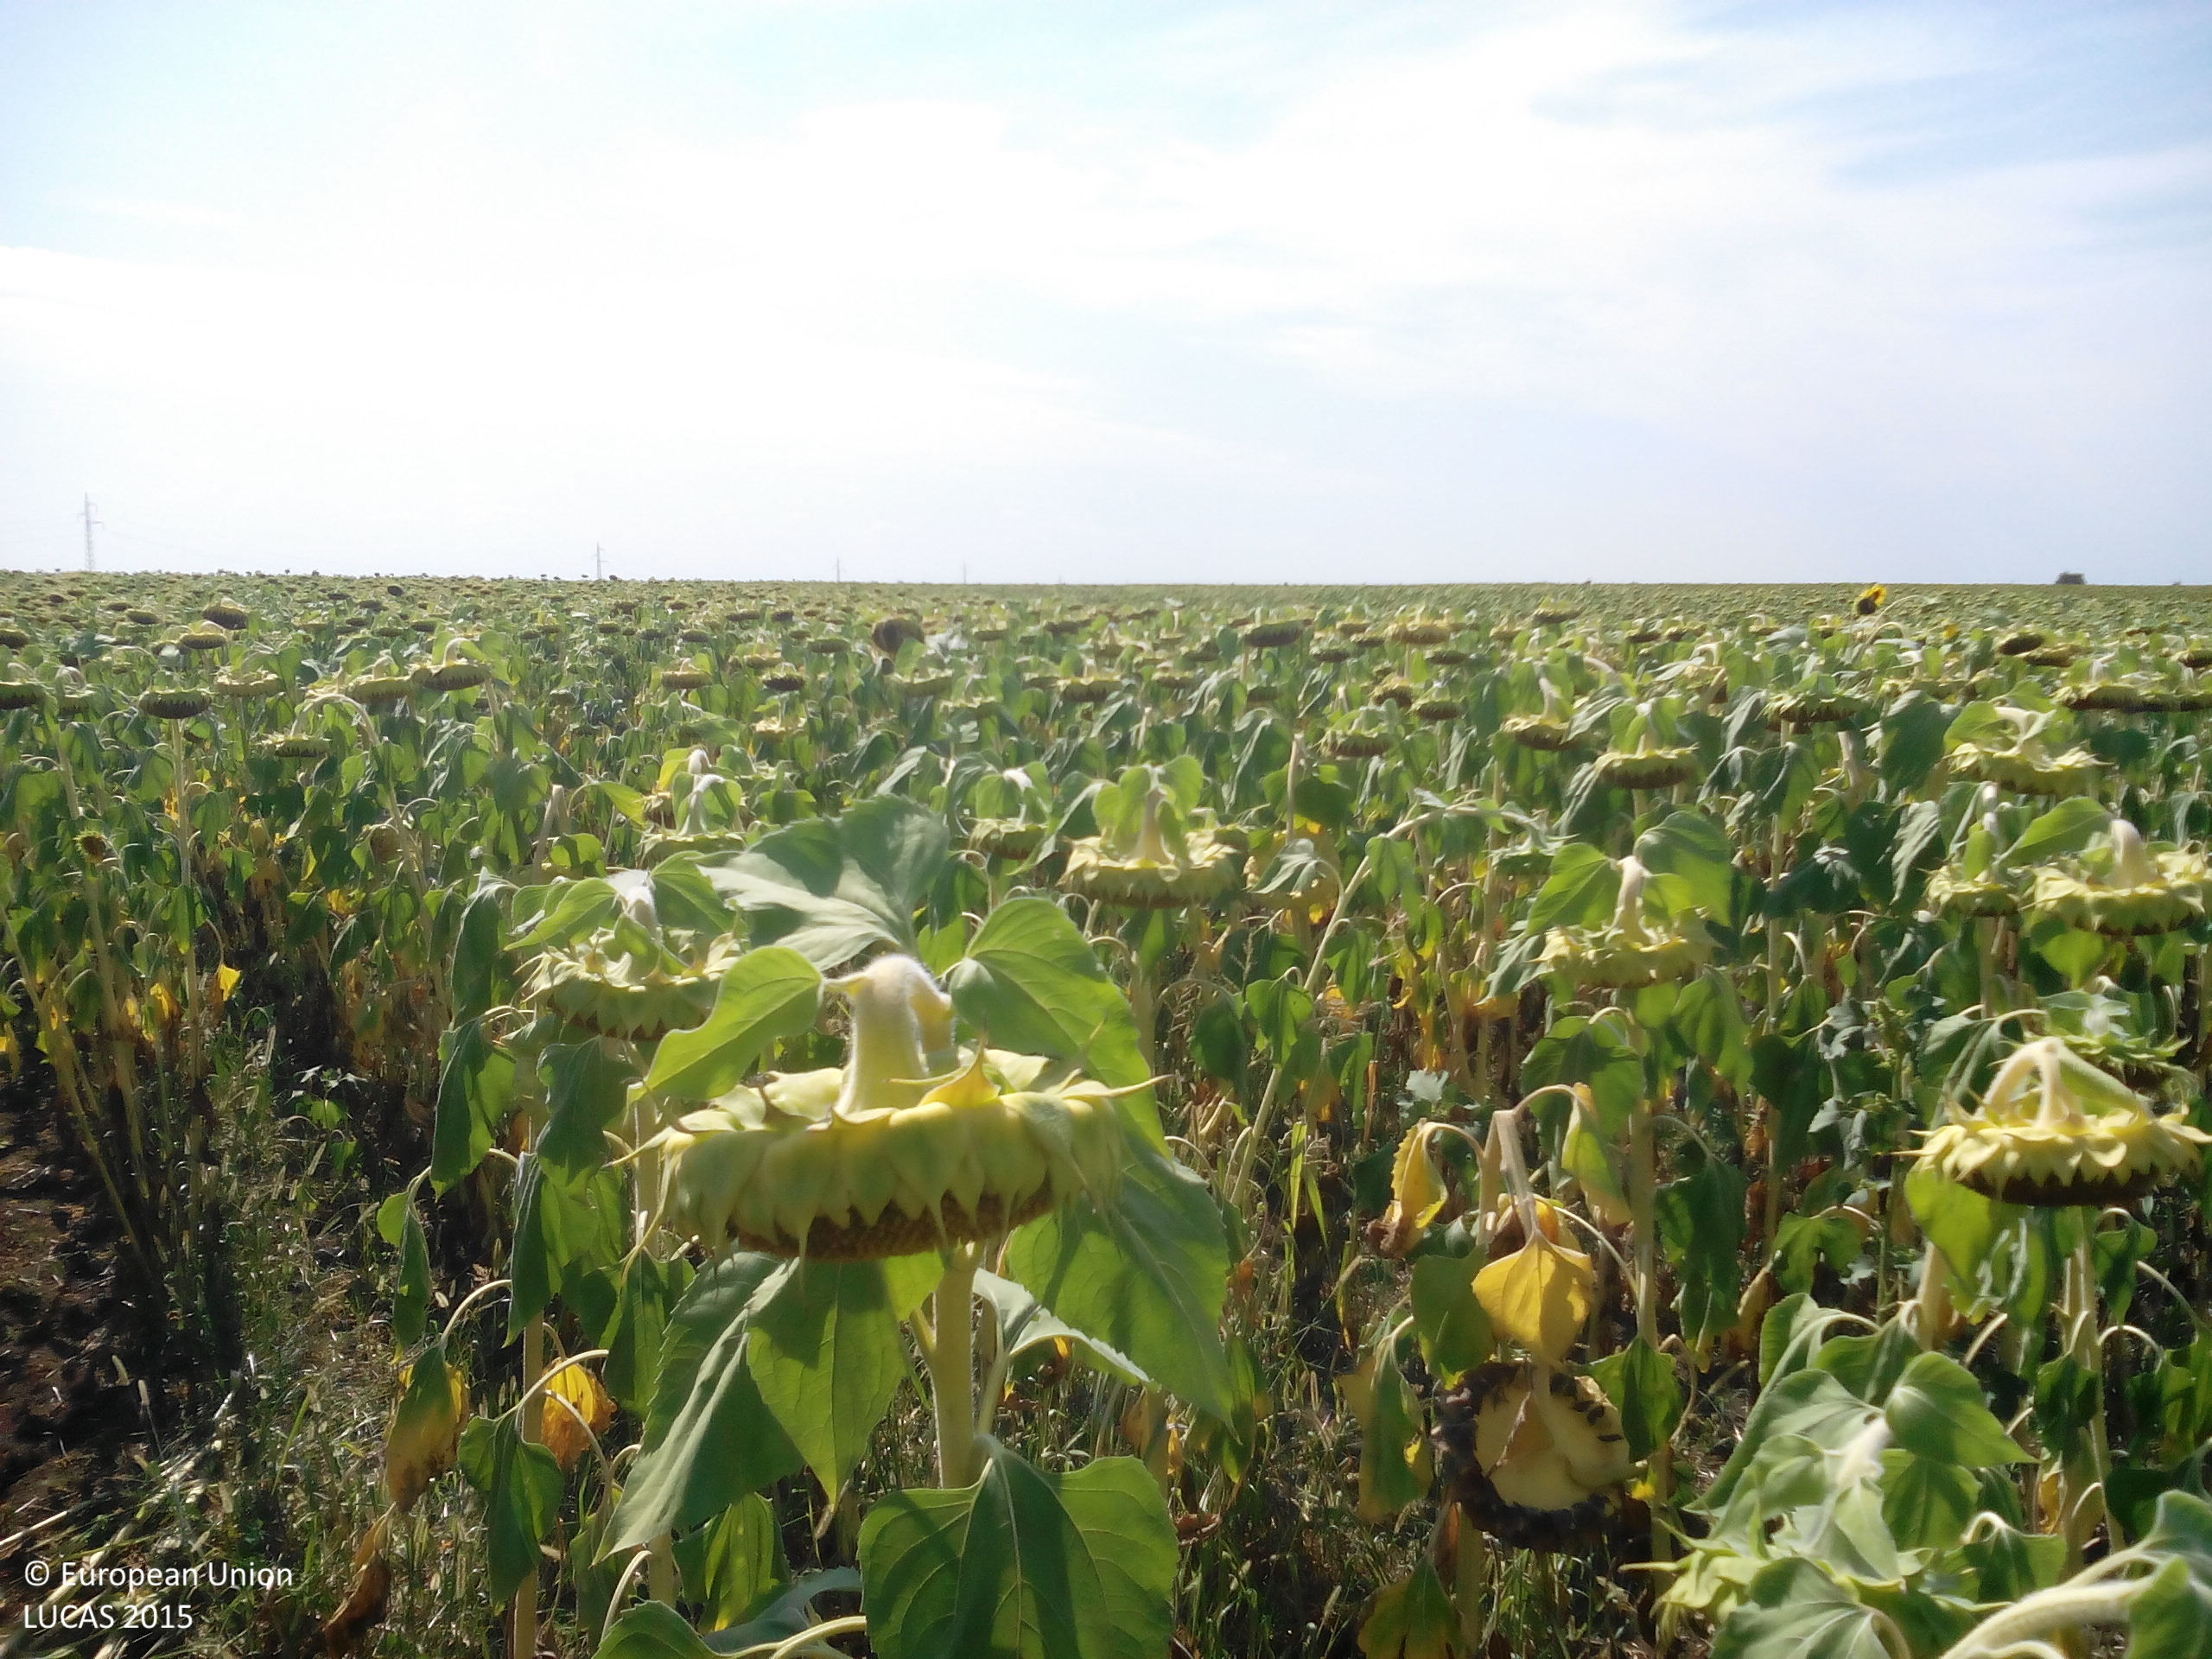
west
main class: Cropland
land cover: Sunflower
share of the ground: > 75 %
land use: Agriculture (excluding fallow land and kitchen gardens)
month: August
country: BG
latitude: 43.4292
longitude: 23.6219
